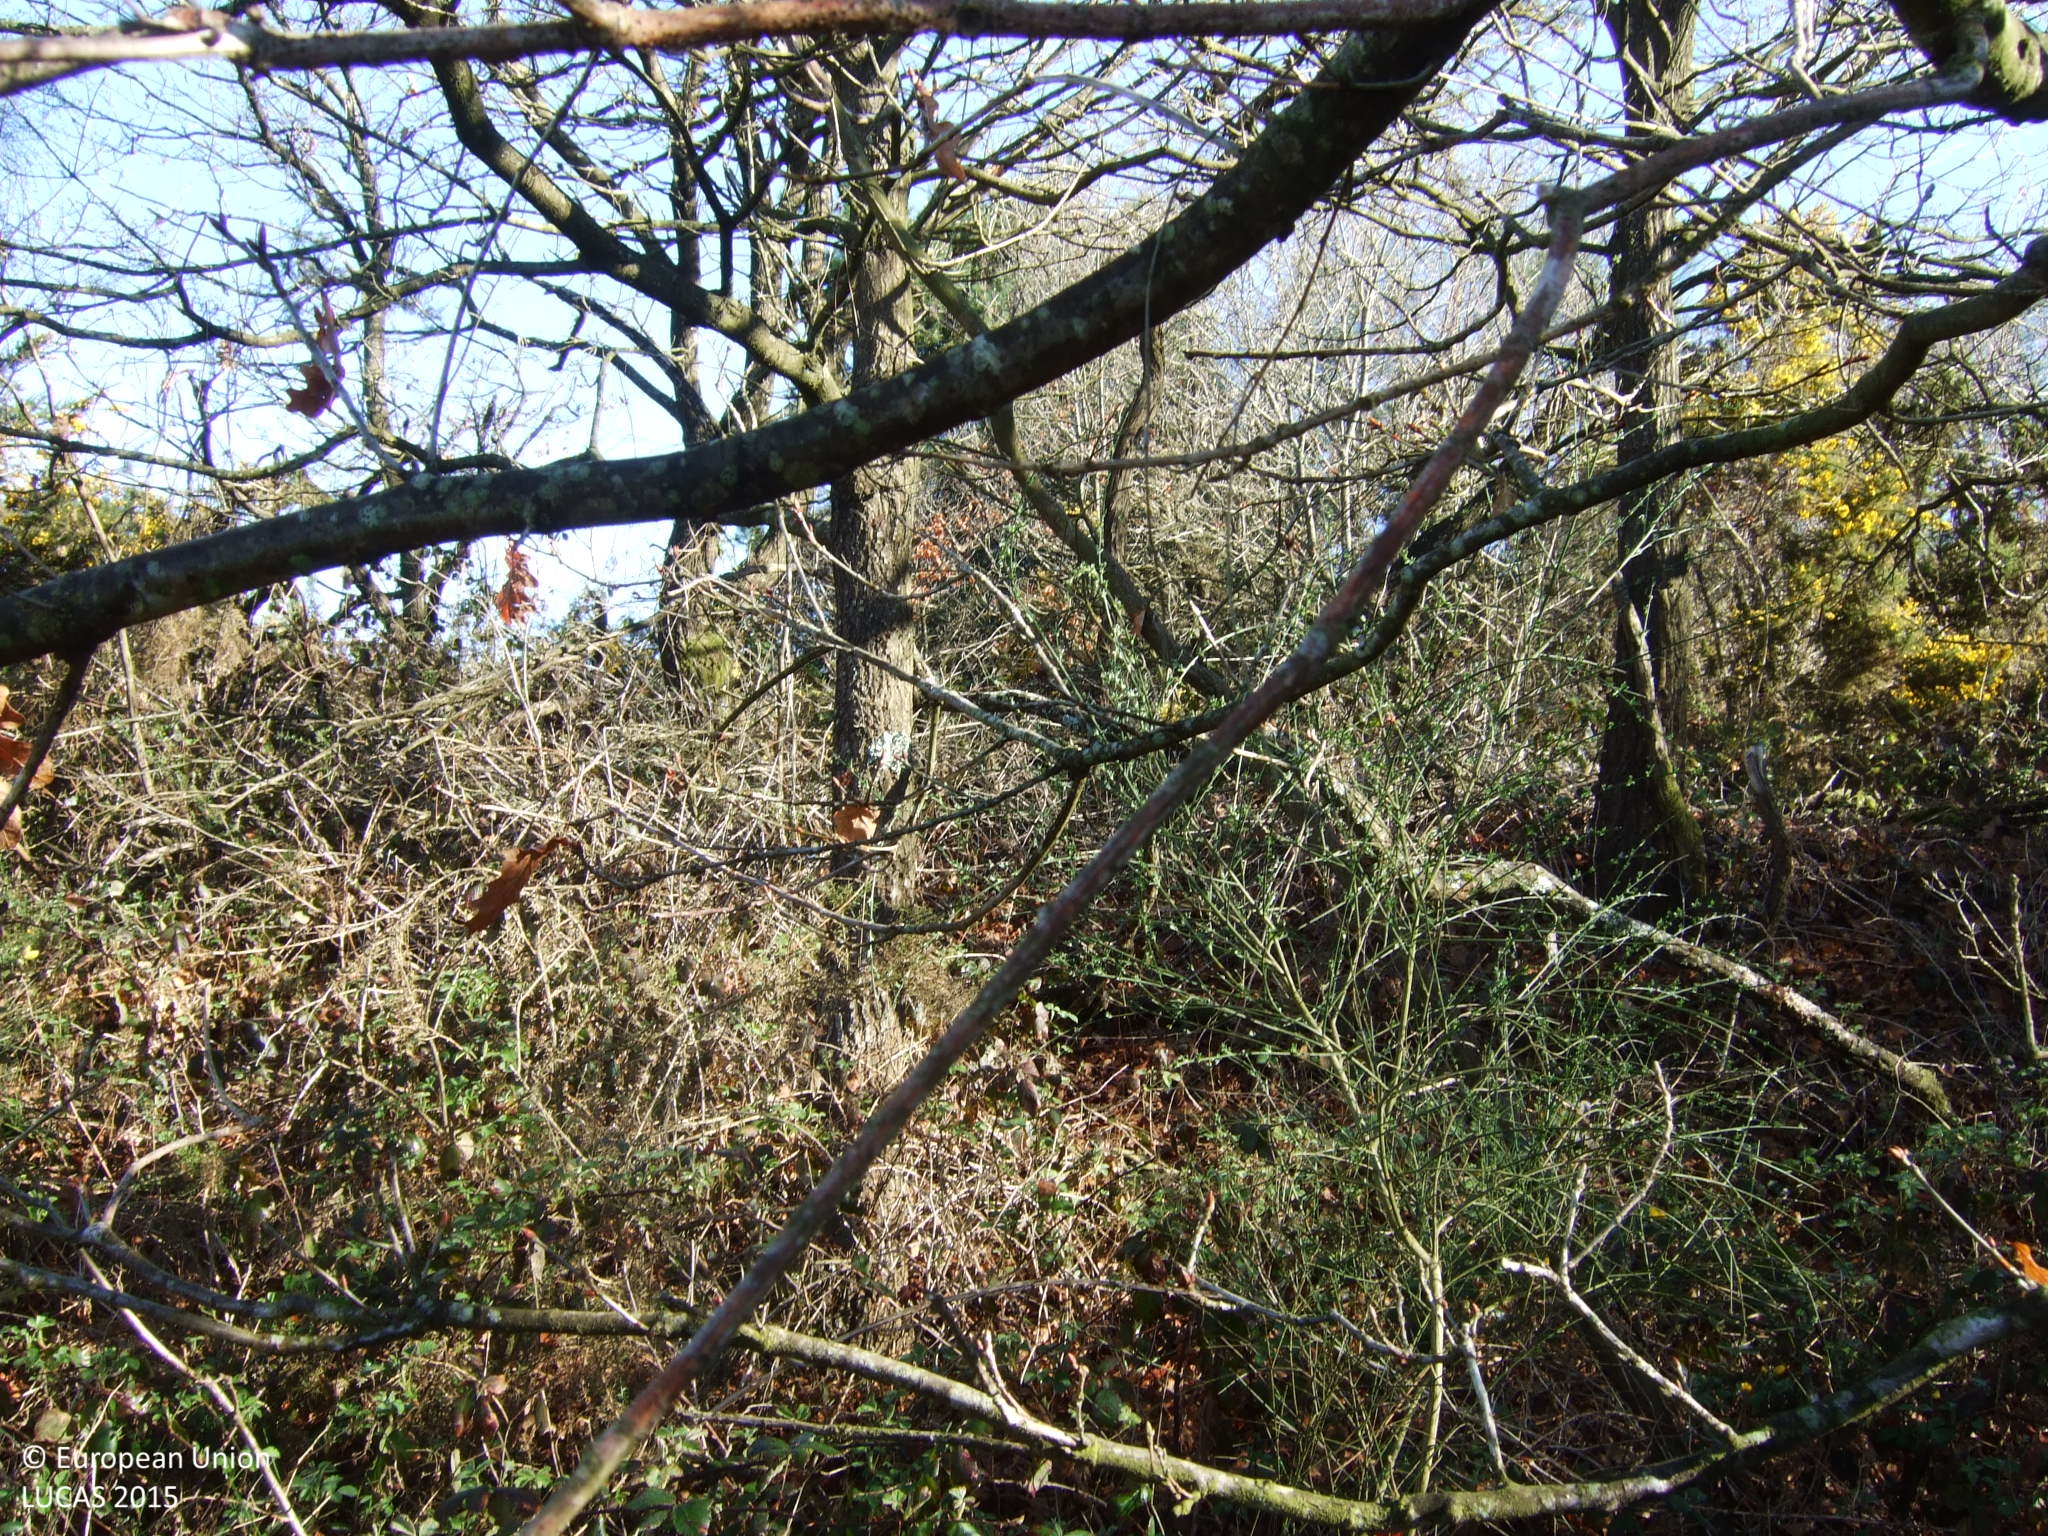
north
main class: Woodland
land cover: Broadleaved woodland
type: acidophilous oak and oak-birch forest
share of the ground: 10 - 25 %
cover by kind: shrubs 50 %, herbaceous plants 30 %, broadleaved forest trees 20 %
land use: Semi-natural and natural areas not in use
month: April
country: ES
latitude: 42.7617
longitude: -7.7868
